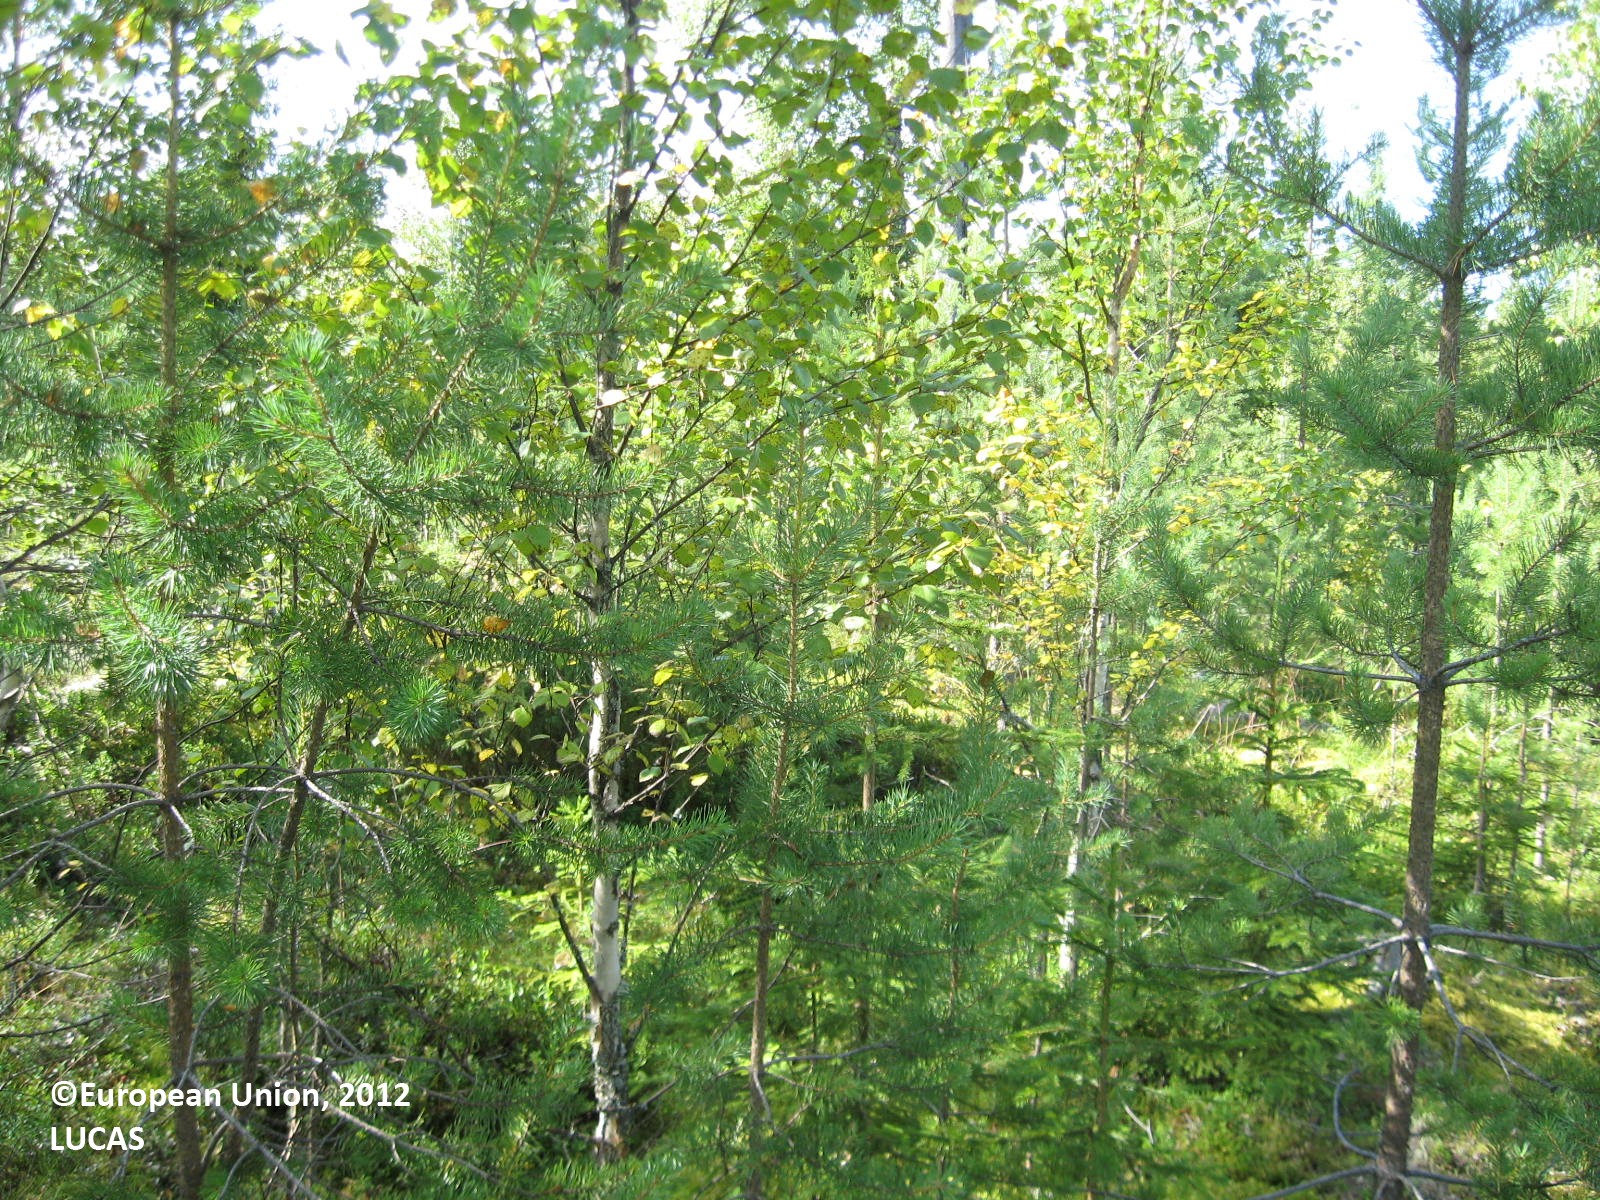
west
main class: Woodland
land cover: Pine dominated mixed woodland
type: boreal forest
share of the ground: > 75 %
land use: Forestry
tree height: > 5 m
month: August
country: FI
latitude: 63.8590
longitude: 28.7679
